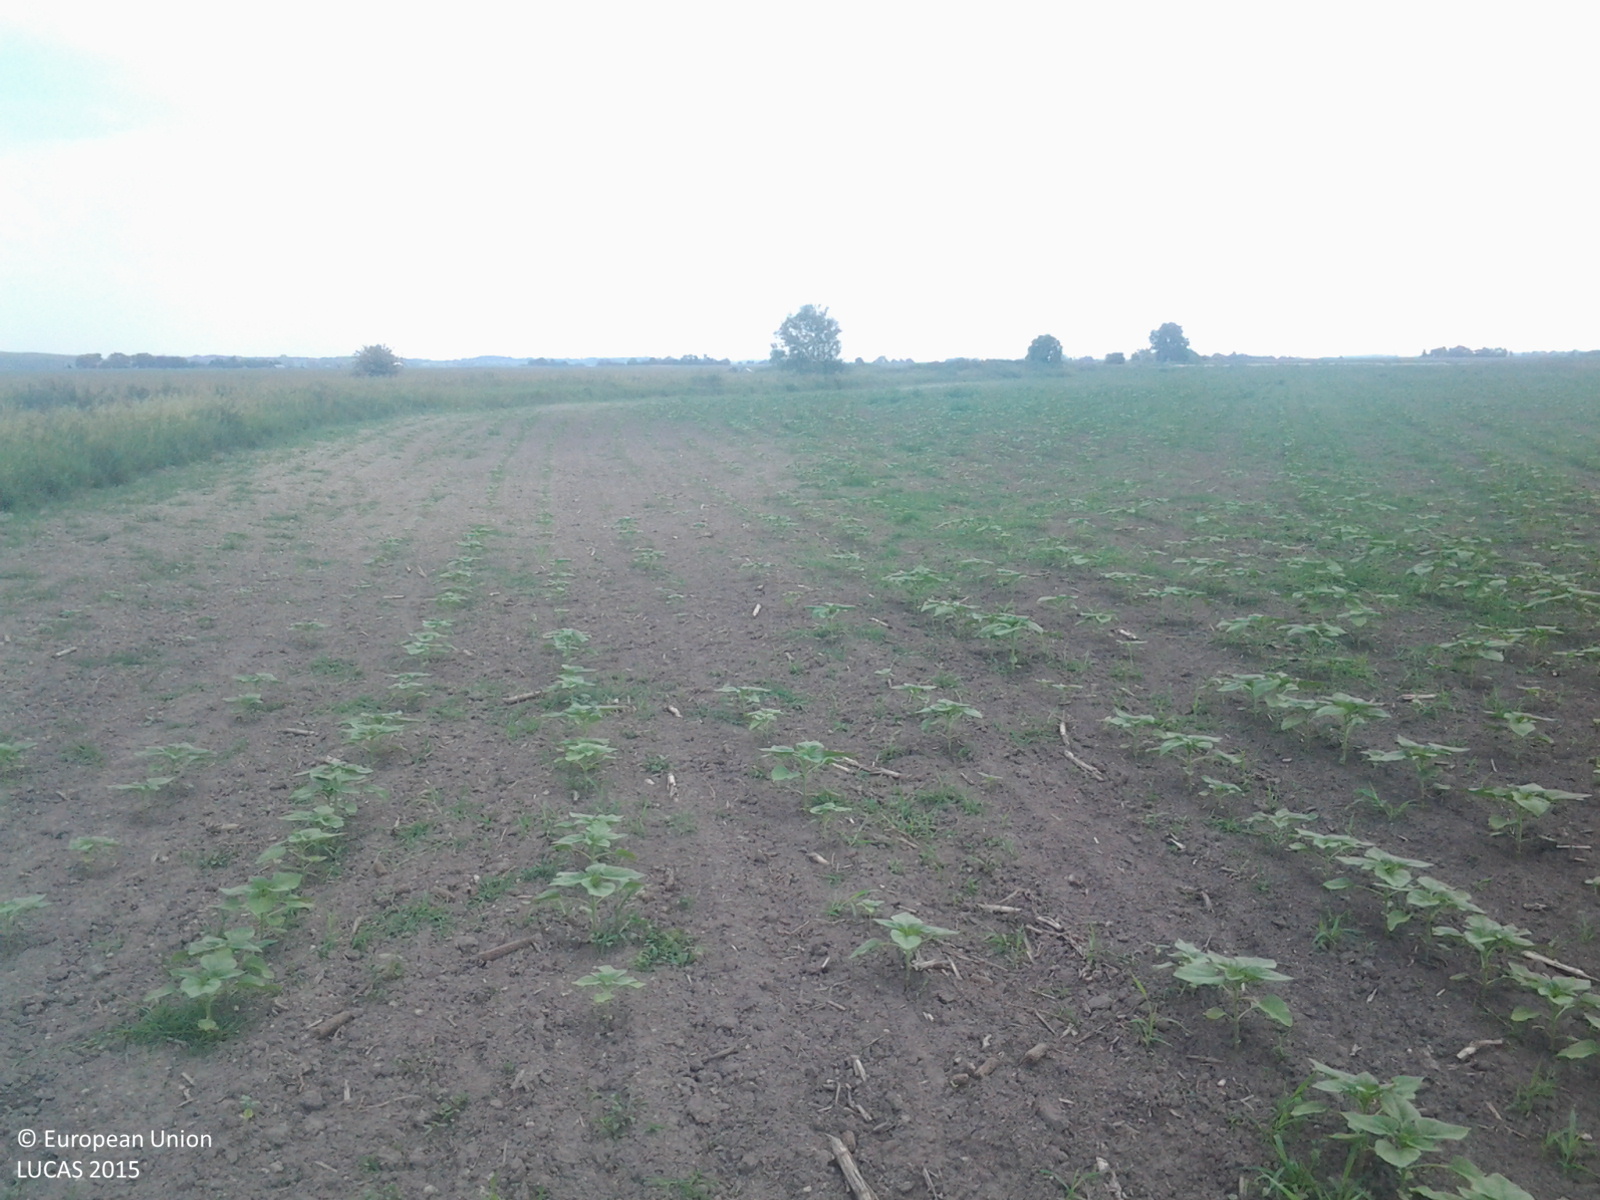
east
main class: Cropland
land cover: Sunflower
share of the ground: < 10 %
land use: Agriculture (excluding fallow land and kitchen gardens)
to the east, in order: Sunflower; Grass margins; Ditches and canals; Fences; Grassland without tree/shrub cover; Ditches and canals; Grass margins; Fences; Tracks; Grassland without tree/shrub cover
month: June
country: HU
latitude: 46.8821
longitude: 19.7712
